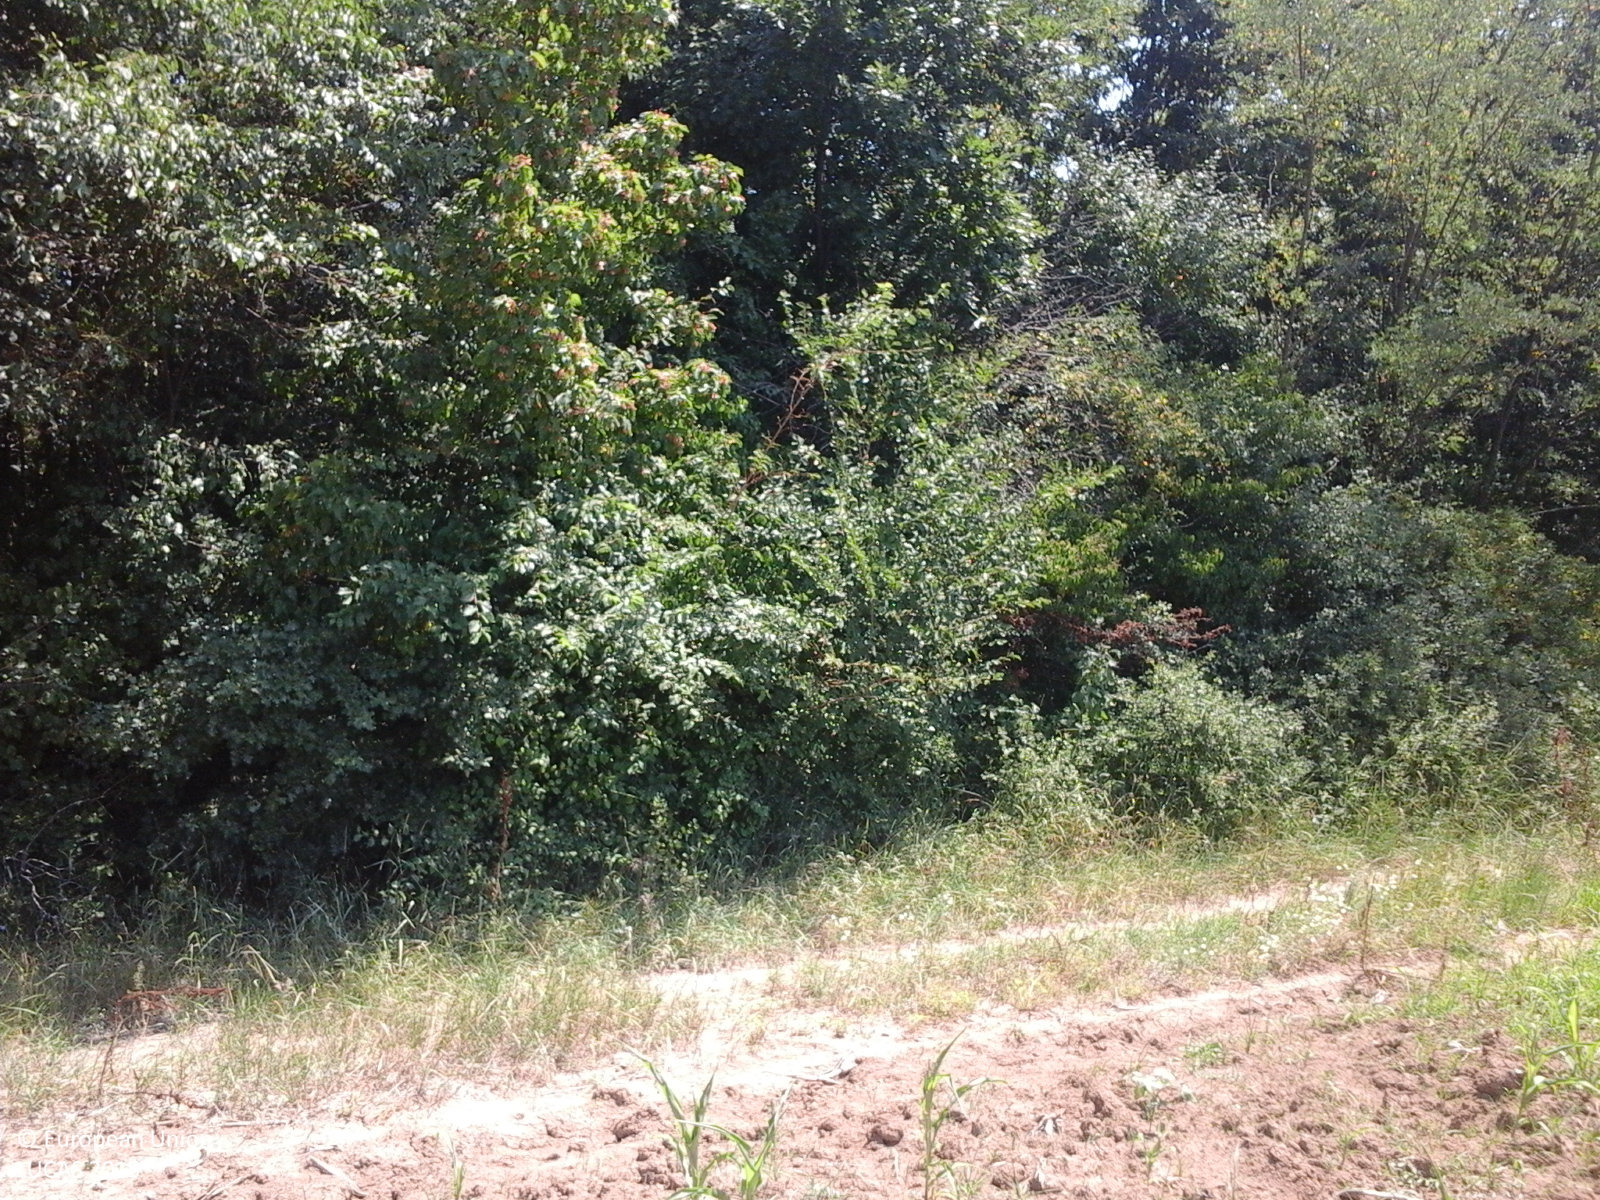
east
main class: Cropland
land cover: Maize
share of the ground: 10 - 25 %
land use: Agriculture (excluding fallow land and kitchen gardens)
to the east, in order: Maize; Tracks; Grass margins; Broadleaved woodland; Grassland without tree/shrub cover; Broadleaved woodland; Grassland with sparse tree/shrub cover; Shrubland with sparse tree cover; Arable land (only in case pi)
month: July
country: RO
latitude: 44.8715
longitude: 24.5686
